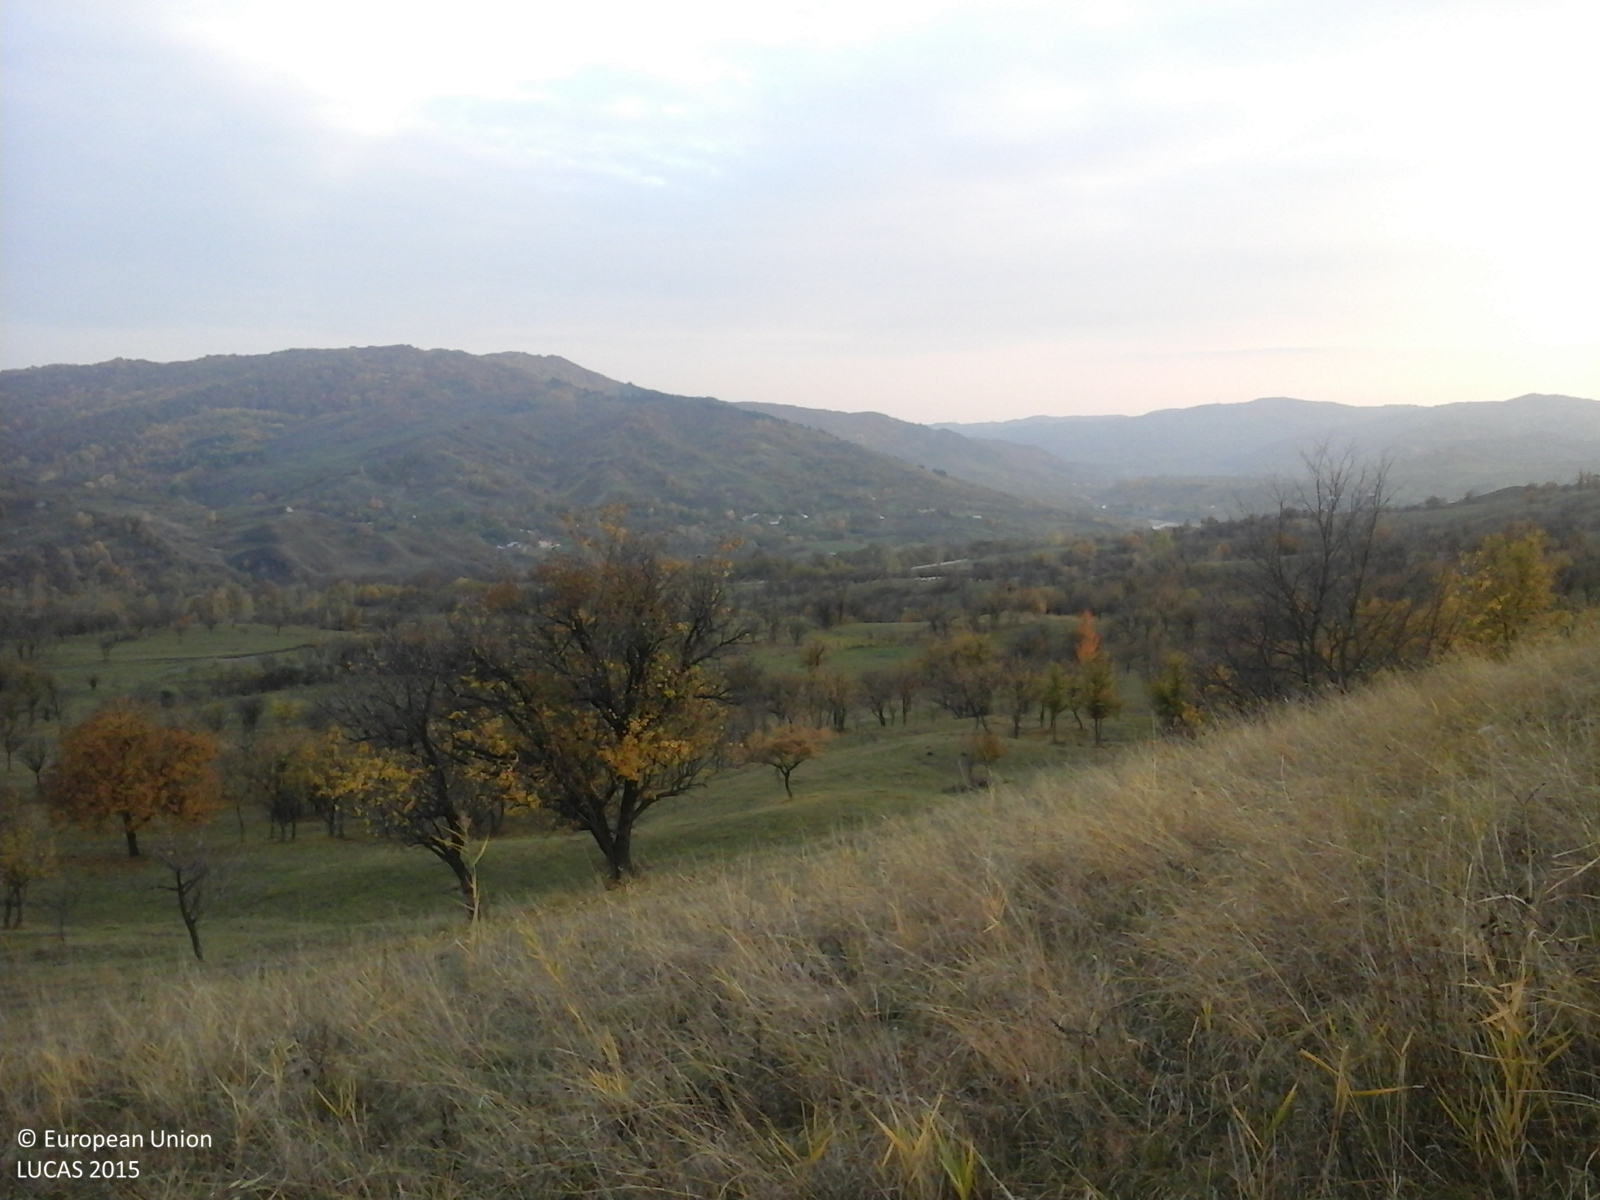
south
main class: Grassland
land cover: Grassland with sparse tree/shrub cover
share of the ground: > 75 %
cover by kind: herbaceous plants 95 %, broadleaved forest trees 5 %
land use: Agriculture (excluding fallow land and kitchen gardens)
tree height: > 5 m
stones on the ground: < 10 %
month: October
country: RO
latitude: 45.4779
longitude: 26.7496
